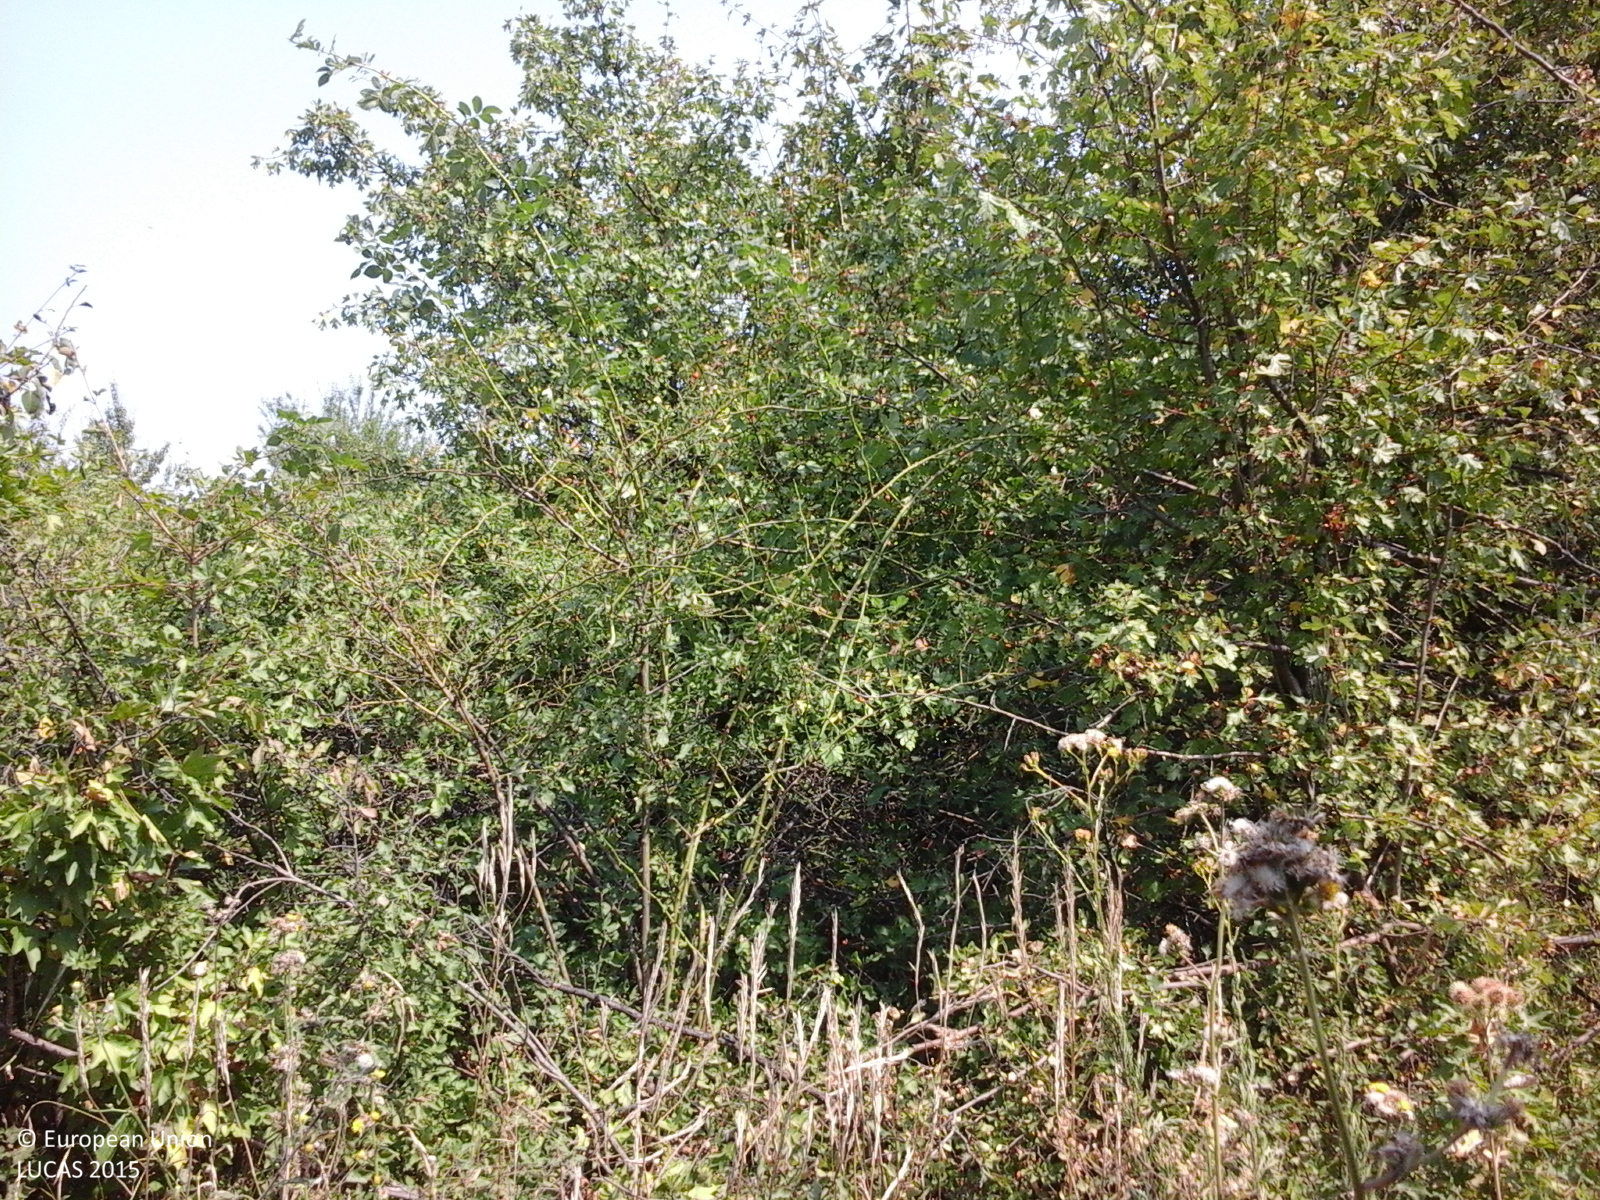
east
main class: Shrubland
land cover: Shrubland with sparse tree cover
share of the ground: > 75 %
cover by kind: shrubs 95 %, broadleaved forest trees 5 %
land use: Semi-natural and natural areas not in use
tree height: > 5 m
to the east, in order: Shrubland with sparse tree cover; Broadleaved woodland
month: August
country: RO
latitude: 44.4116
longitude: 23.3746
